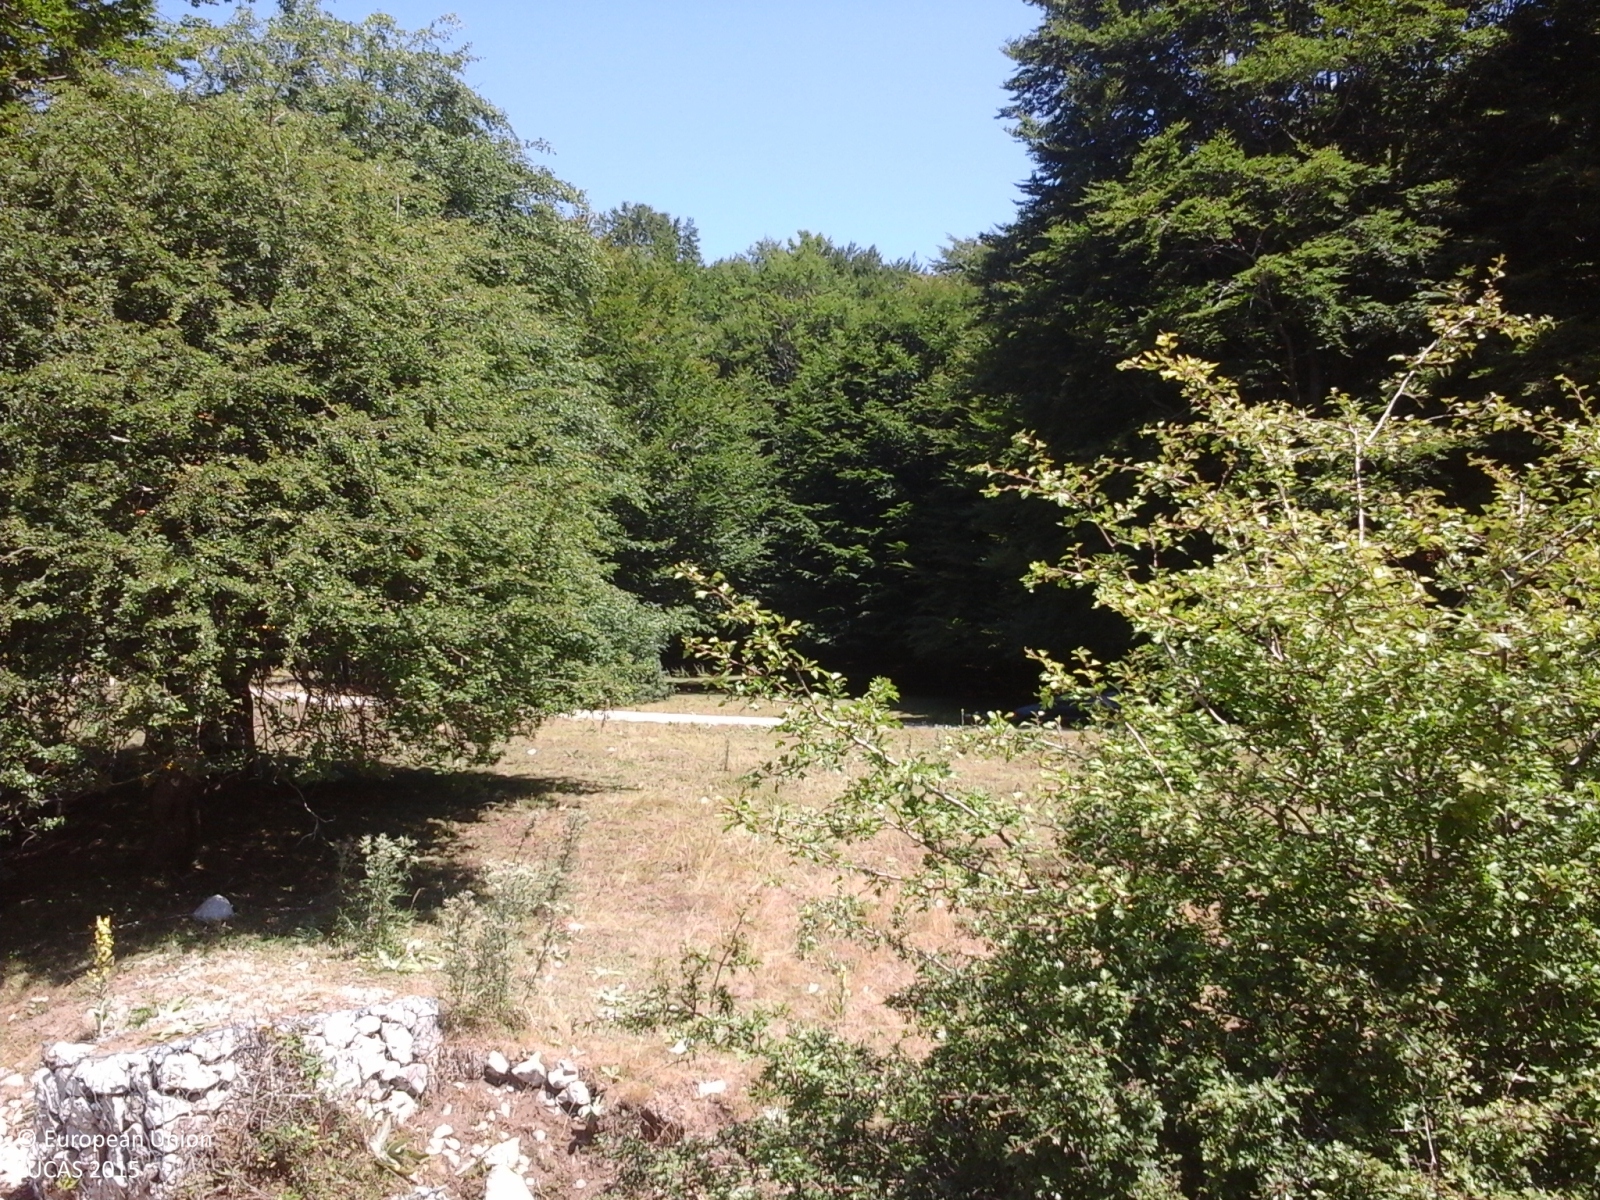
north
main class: Grassland
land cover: Grassland without tree/shrub cover
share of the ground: > 75 %
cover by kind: herbaceous plants 100 %
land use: Agriculture (excluding fallow land and kitchen gardens)
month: July
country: IT
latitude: 40.7867
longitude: 15.1109
